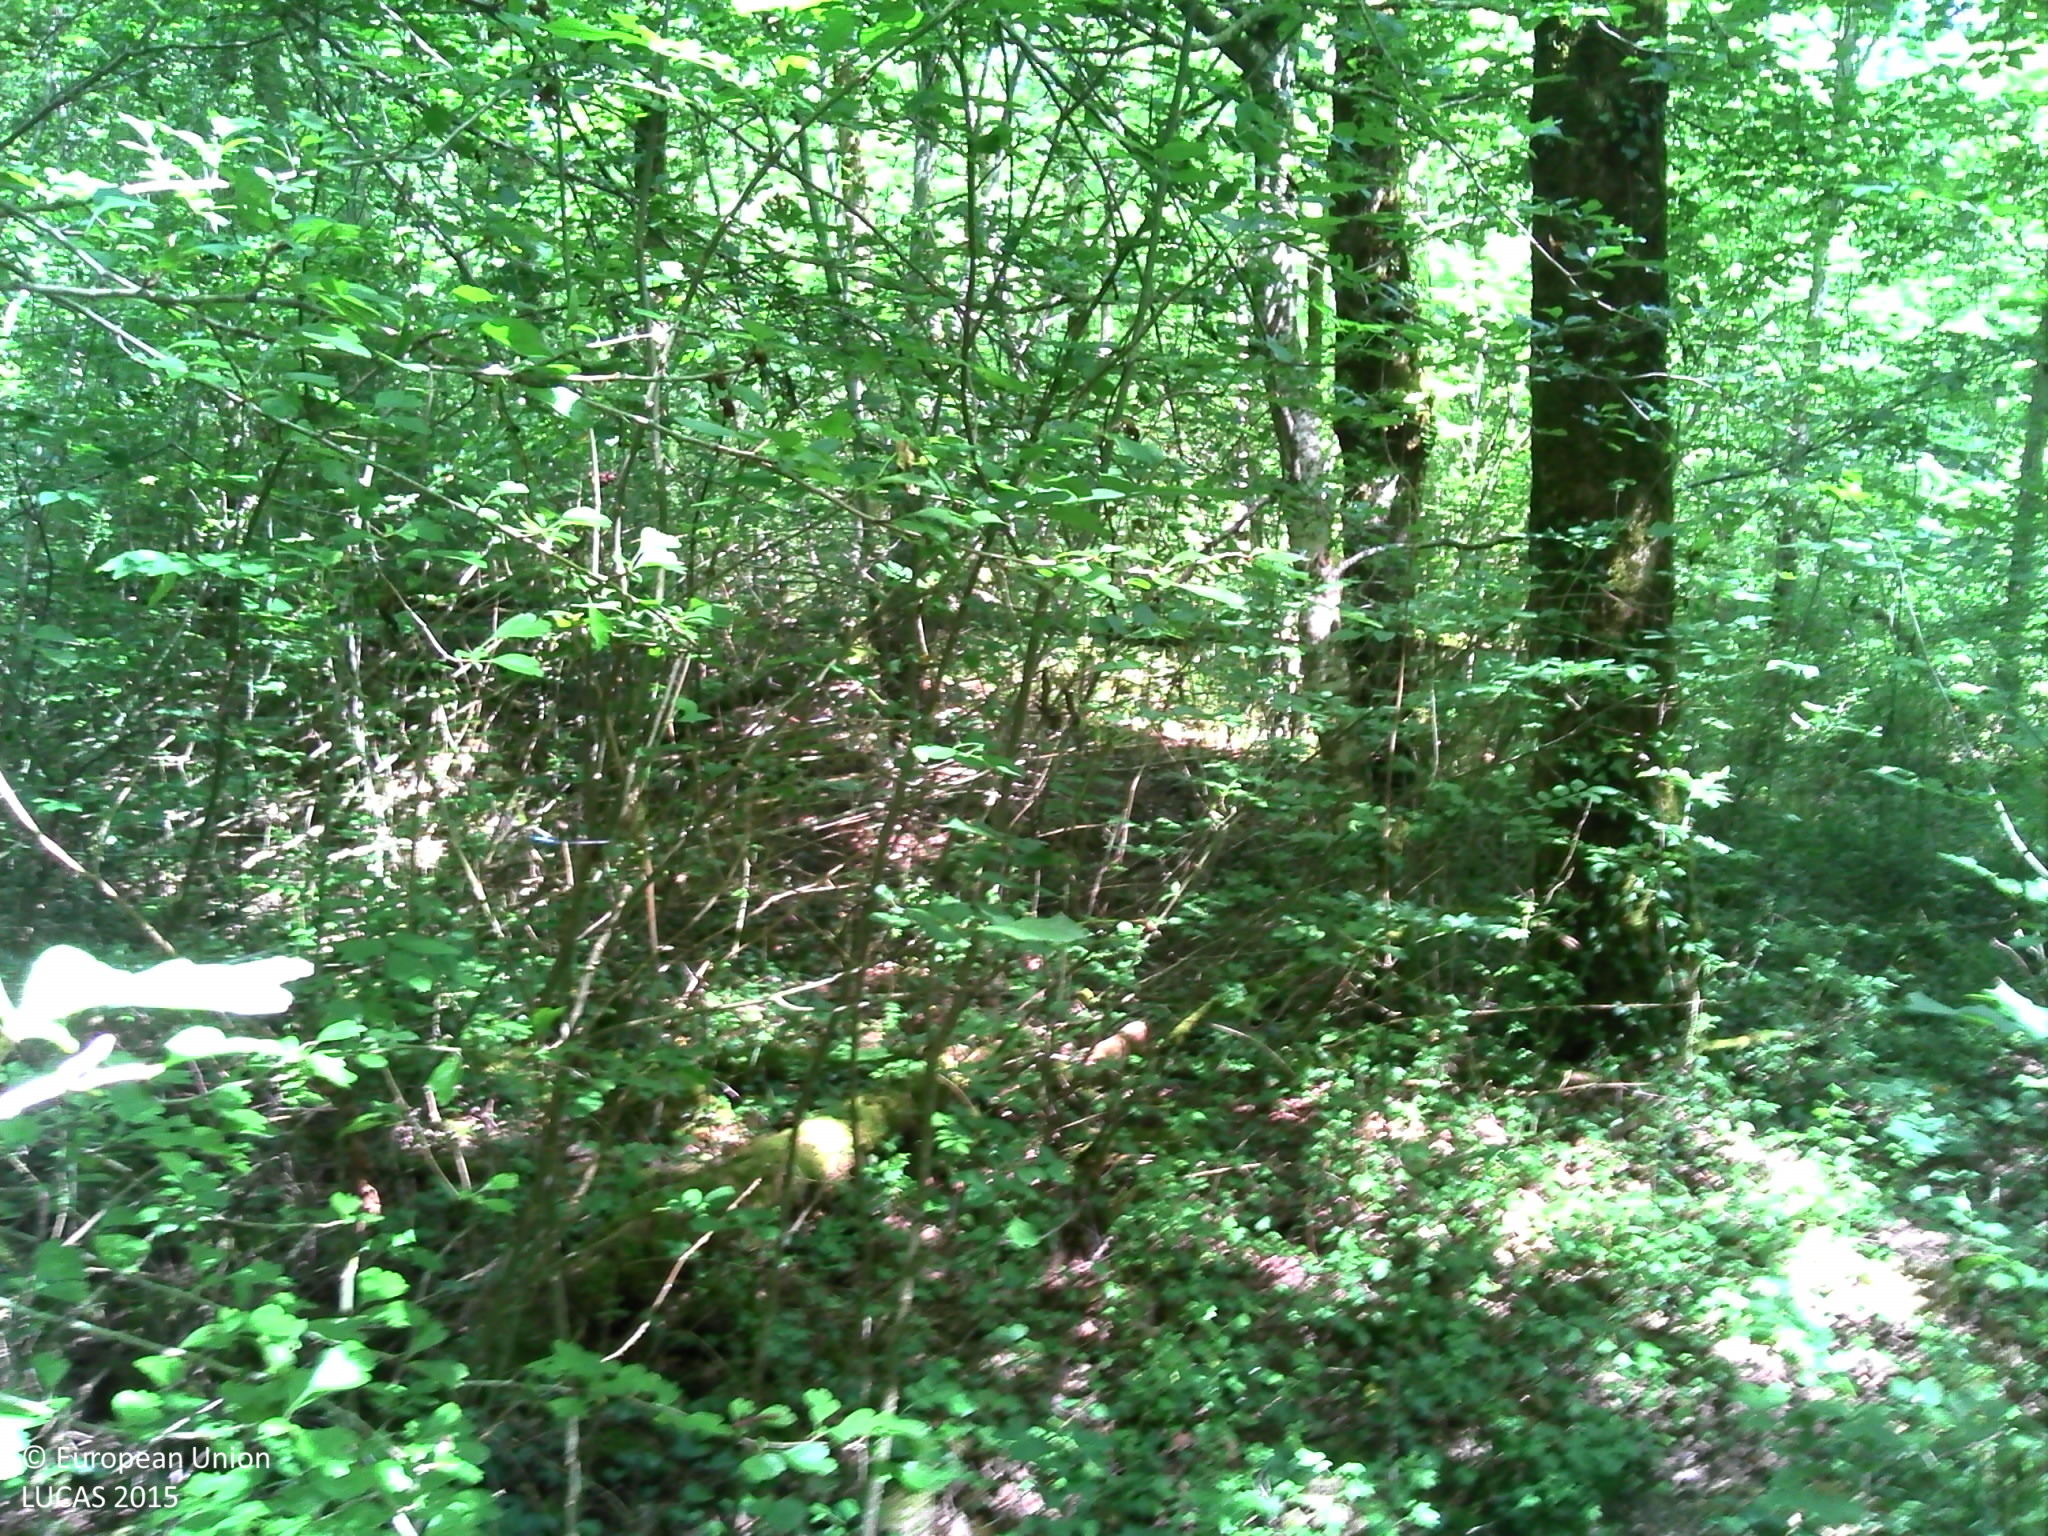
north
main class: Woodland
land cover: Broadleaved woodland
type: mesophytic deciduous forest
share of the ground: > 75 %
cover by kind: broadleaved forest trees 95 %, herbaceous plants 5 %
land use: Semi-natural and natural areas not in use
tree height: > 5 m
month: June
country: FR
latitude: 44.7862
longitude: 1.7956
